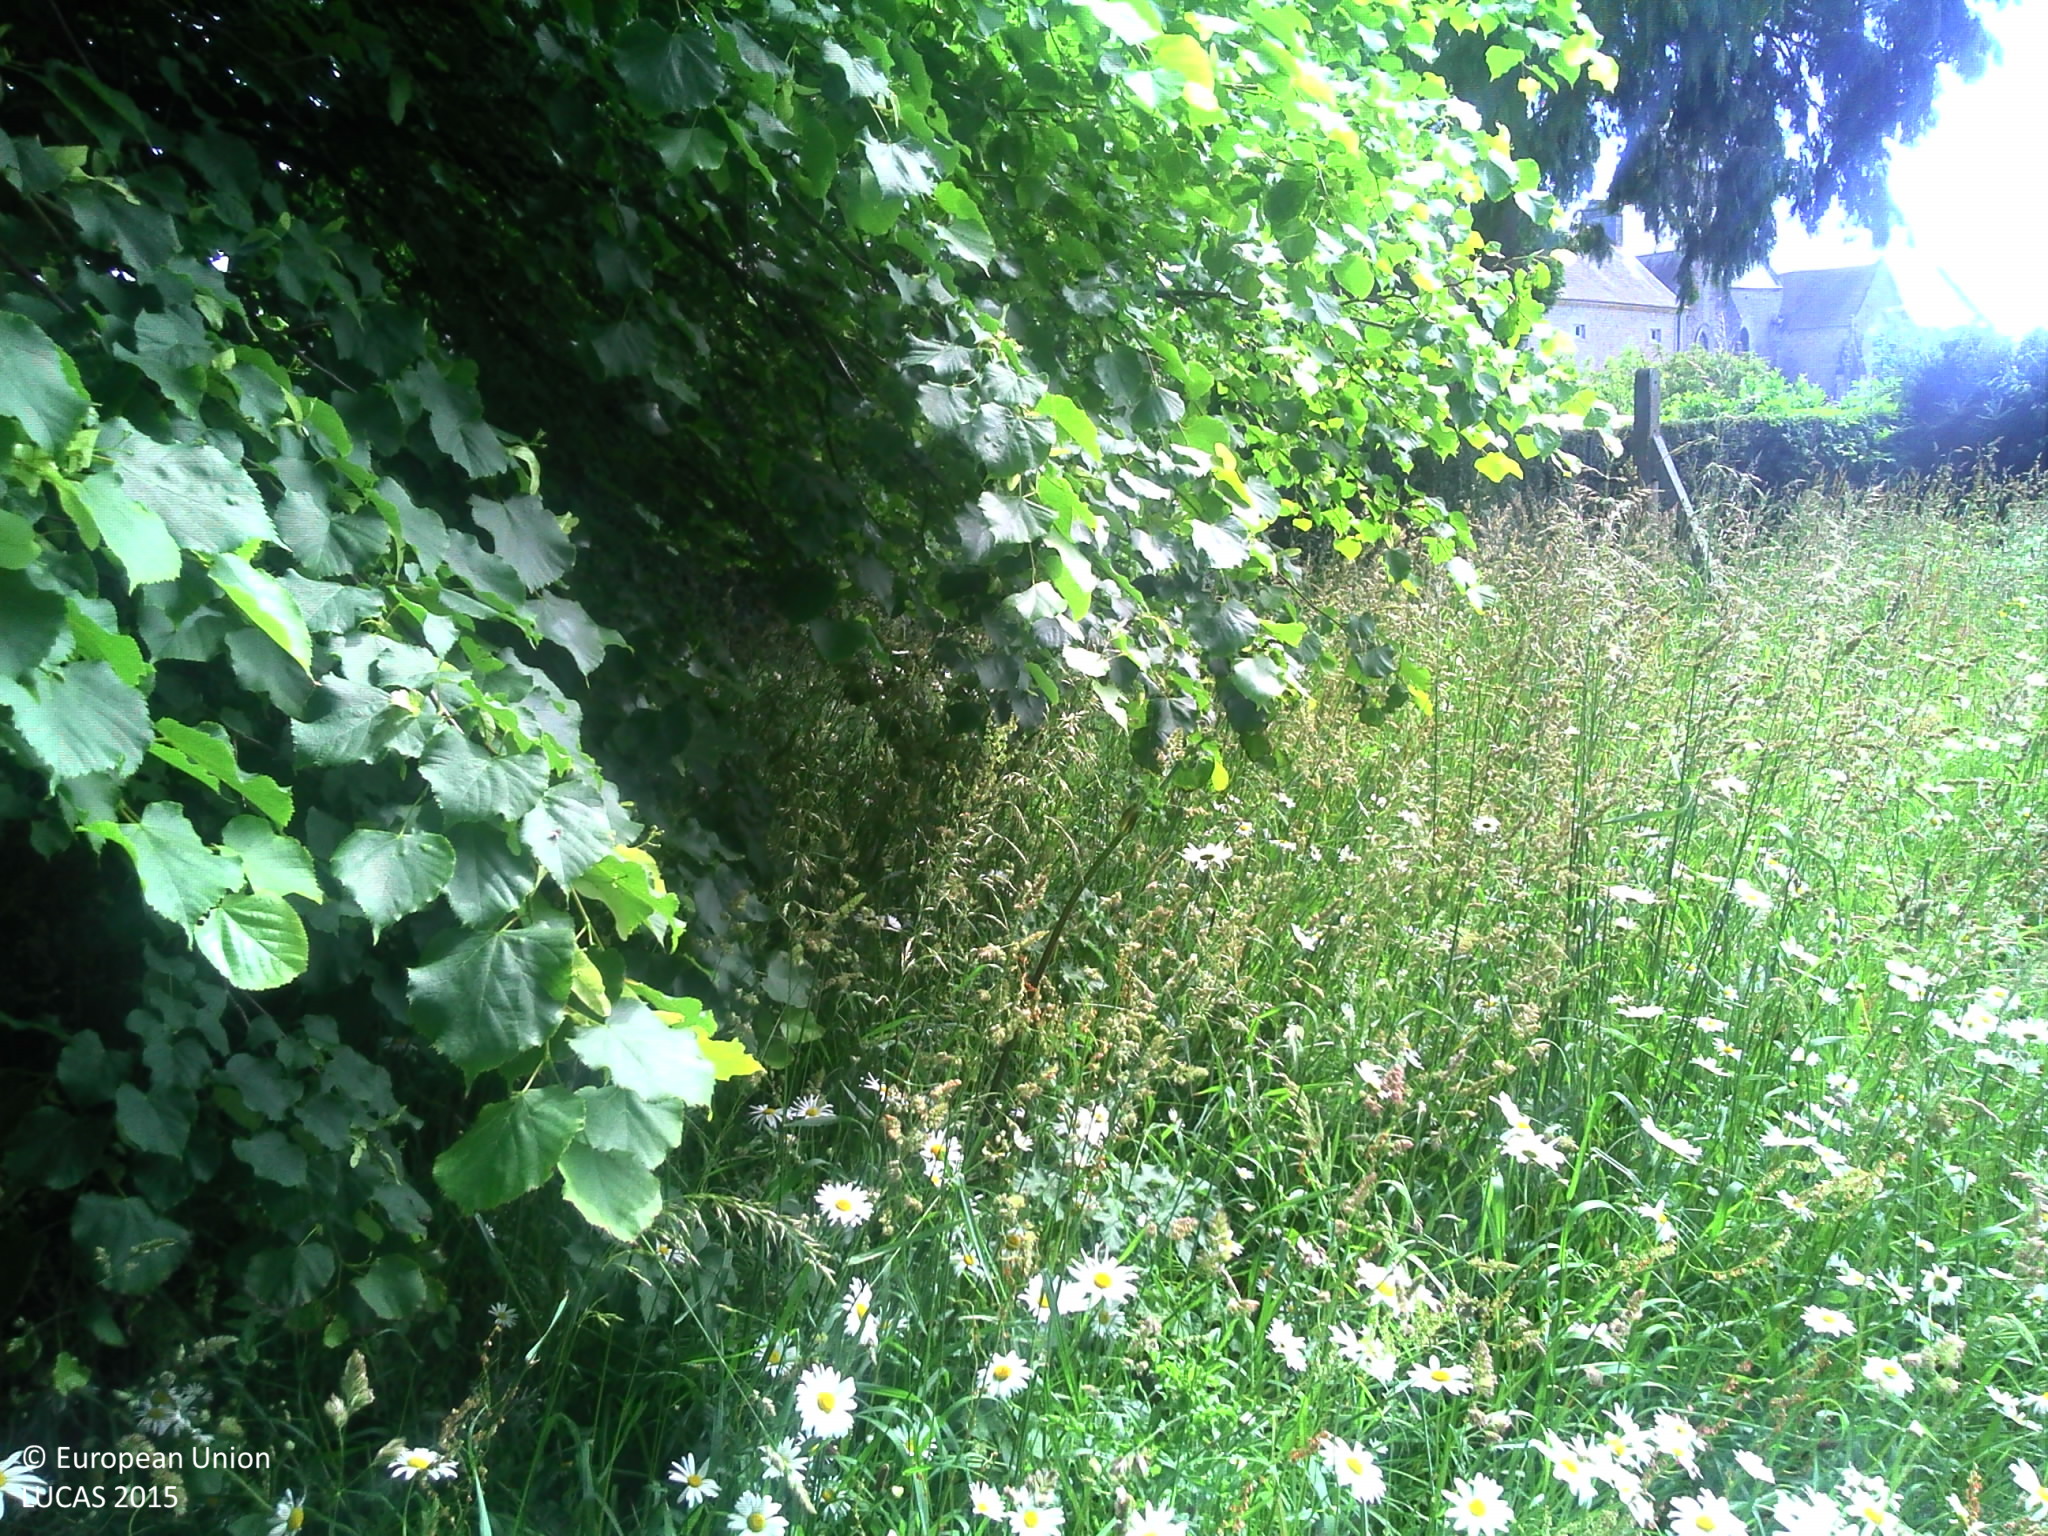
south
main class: Grassland
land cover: Grassland with sparse tree/shrub cover
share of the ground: > 75 %
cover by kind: herbaceous plants 95 %, broadleaved forest trees 5 %
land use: Semi-natural and natural areas not in use
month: June
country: FR
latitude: 49.4114
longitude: -1.3912
